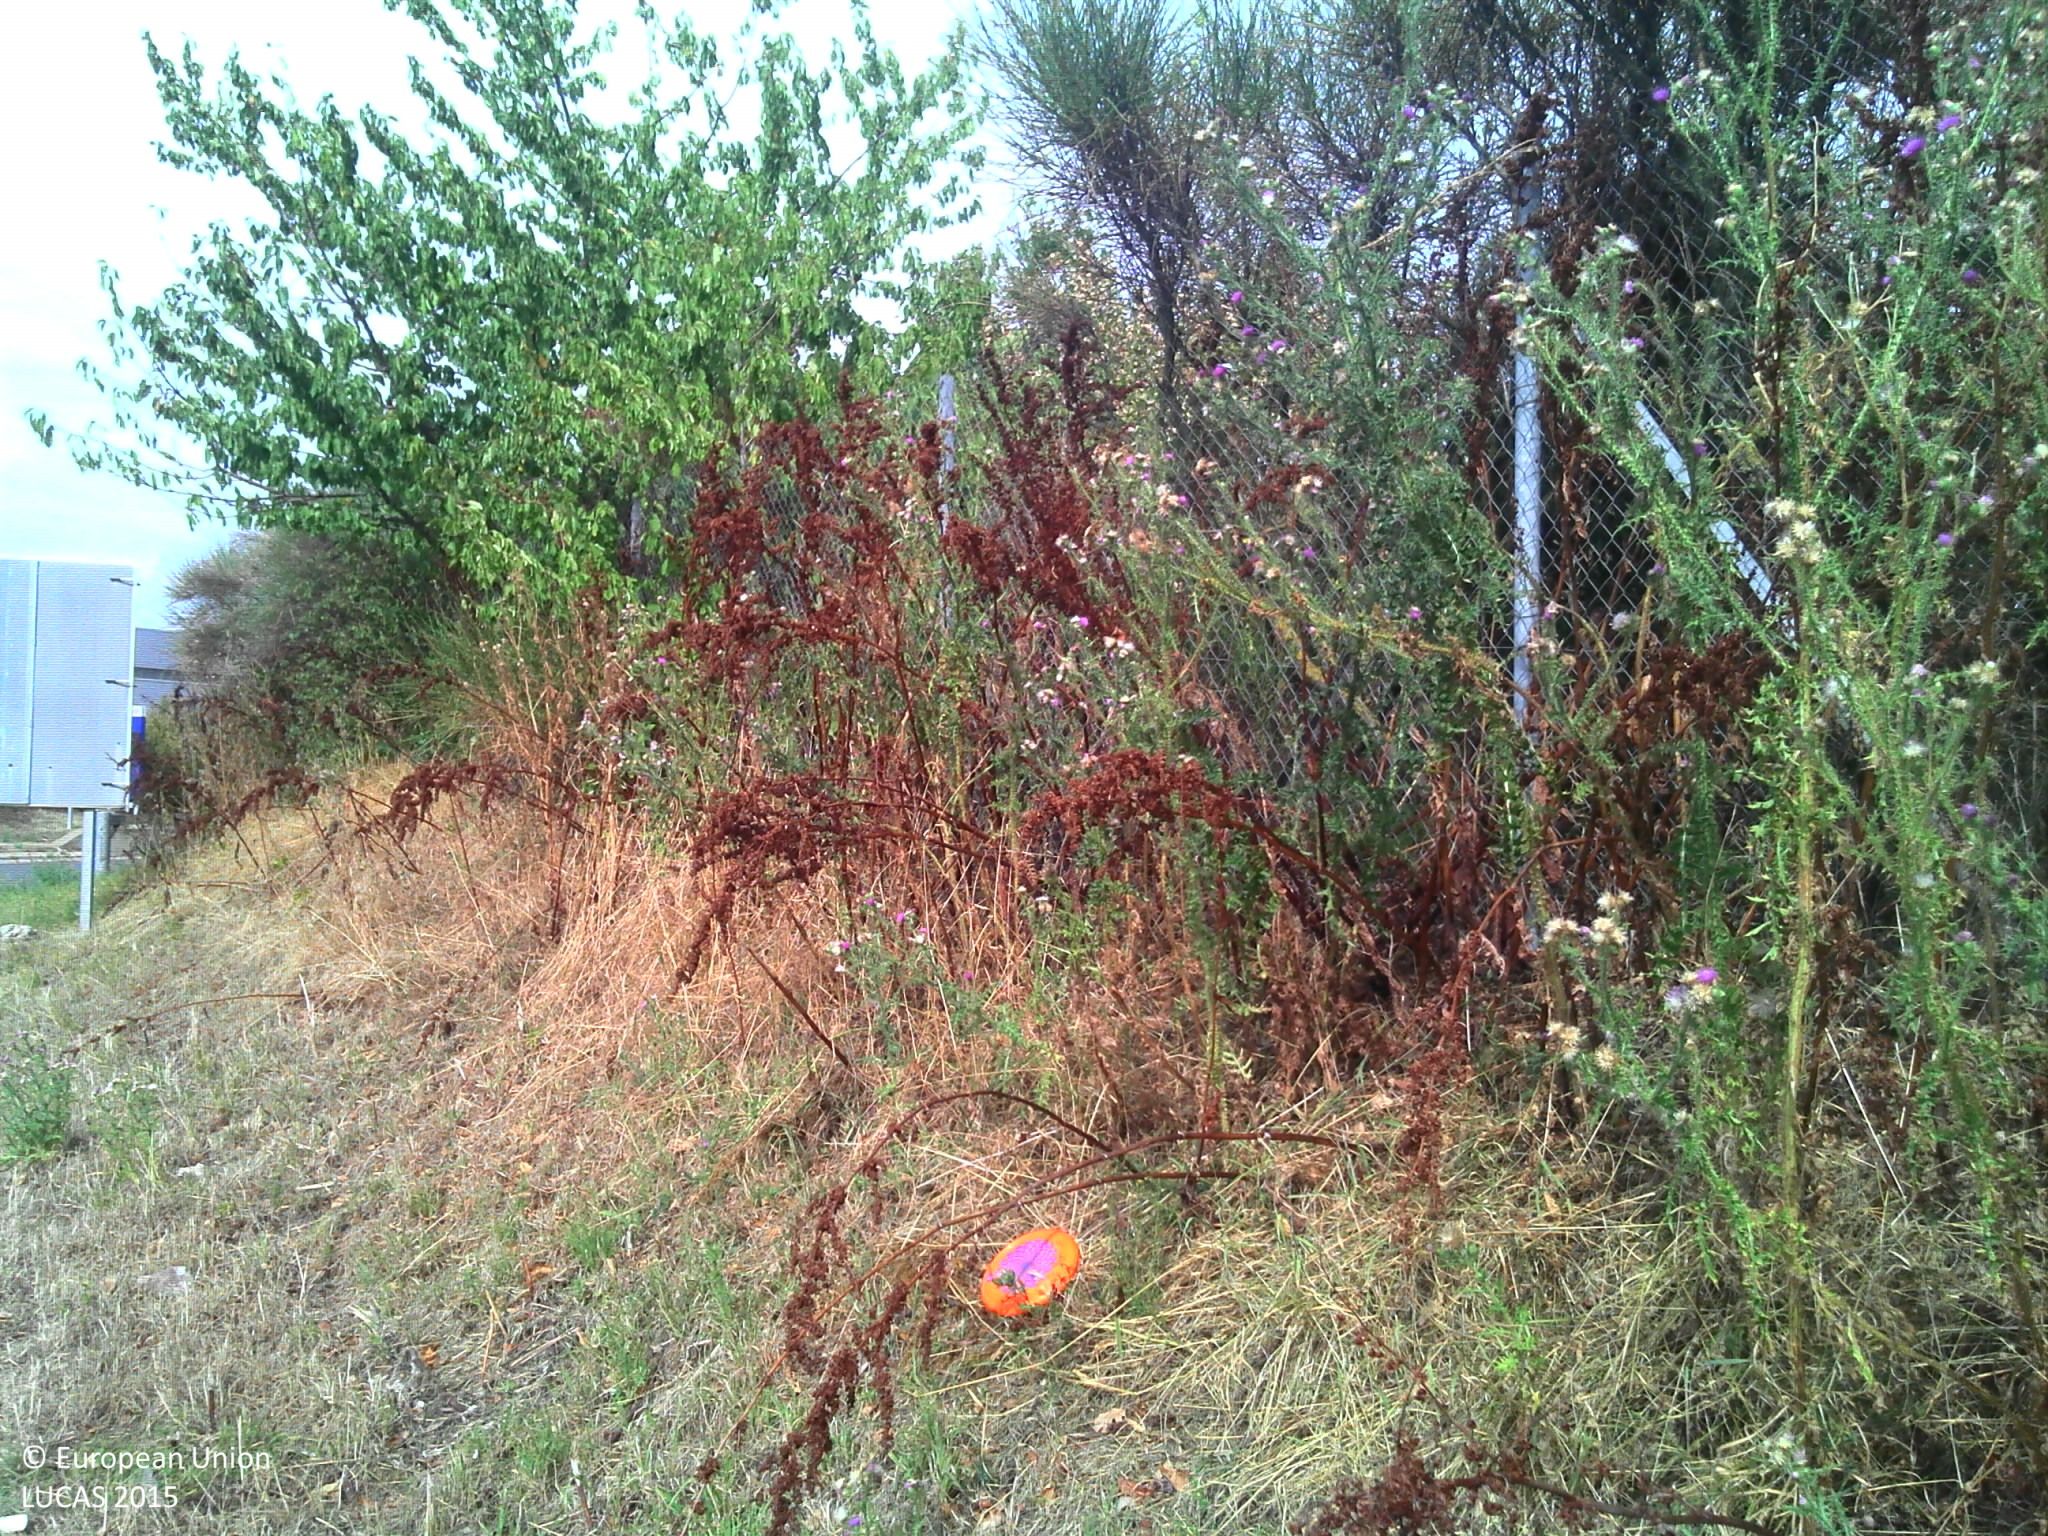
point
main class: Grassland
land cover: Spontaneously vegetated surfaces
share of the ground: > 75 %
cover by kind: herbaceous plants 85 %, lichens and mosses 10 %, shrubs 5 %
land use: Semi-natural and natural areas not in use
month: July
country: FR
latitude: 45.6716
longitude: 4.9334
